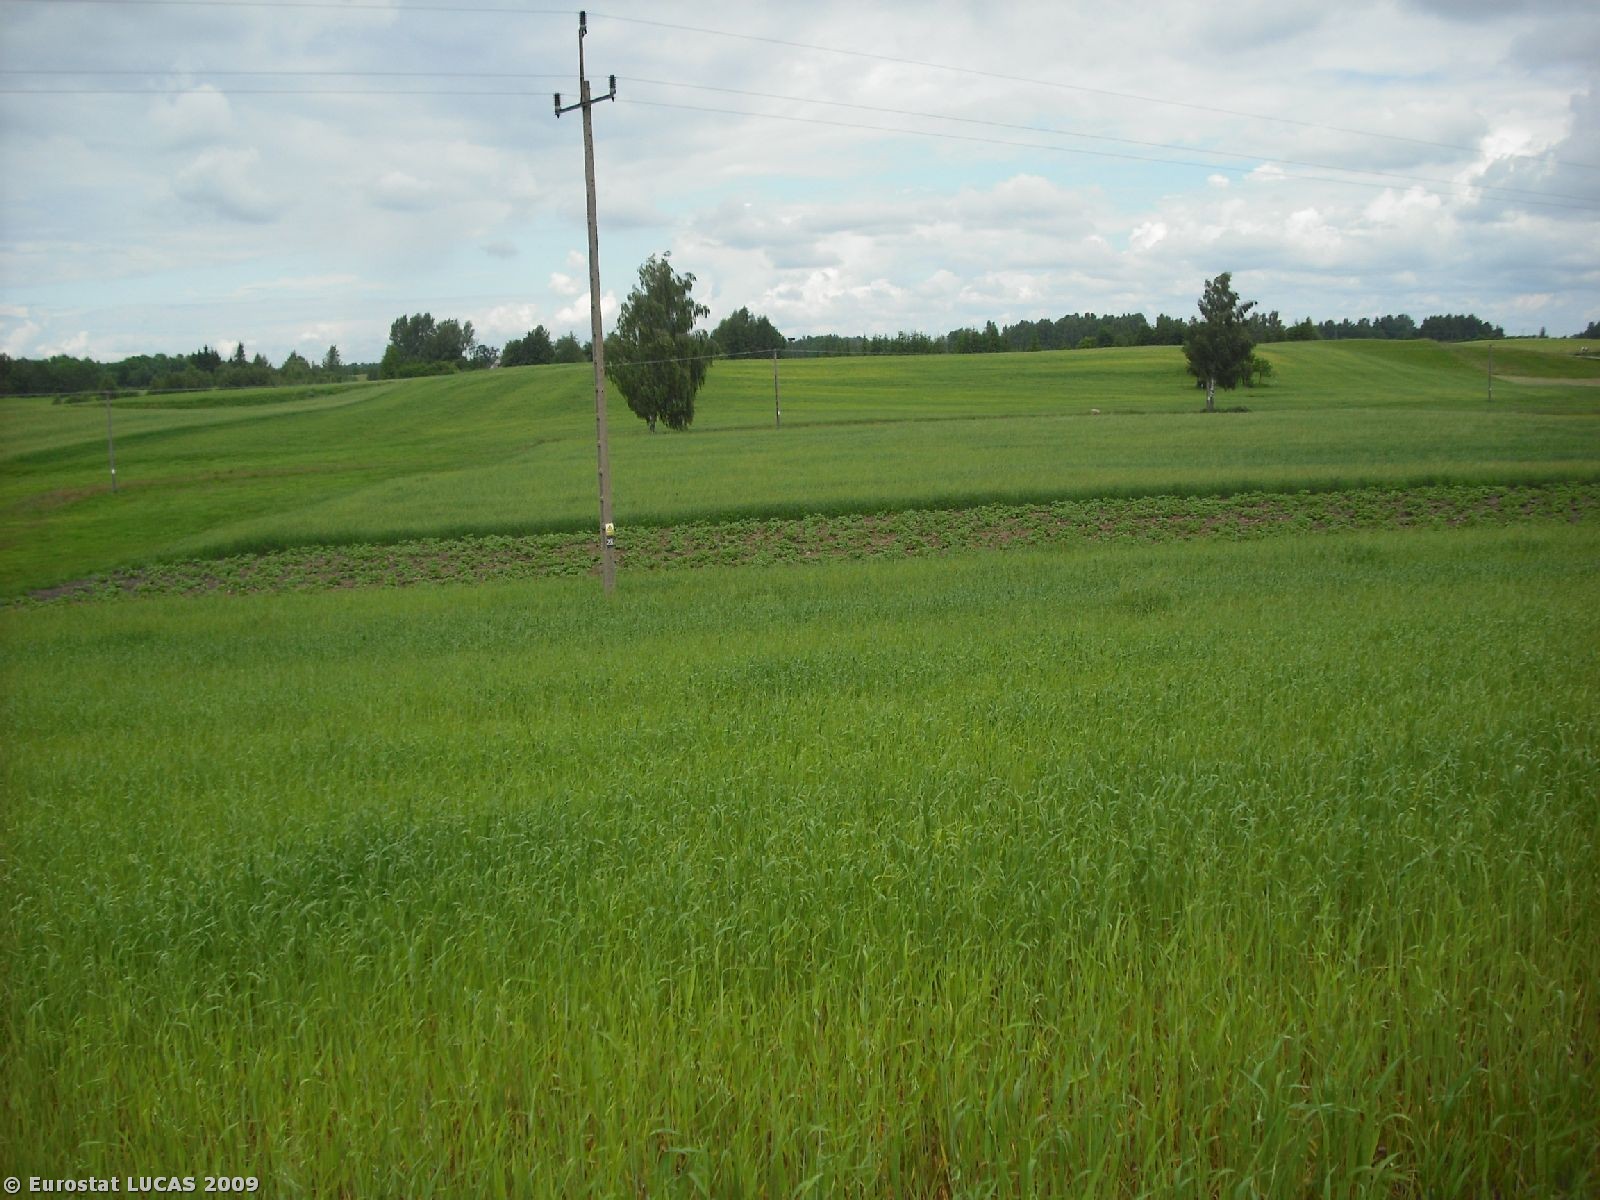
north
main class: Cropland
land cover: Oats
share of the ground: > 75 %
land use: Agriculture (excluding fallow land and kitchen gardens)
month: June
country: PL
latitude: 54.1710
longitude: 23.3610
